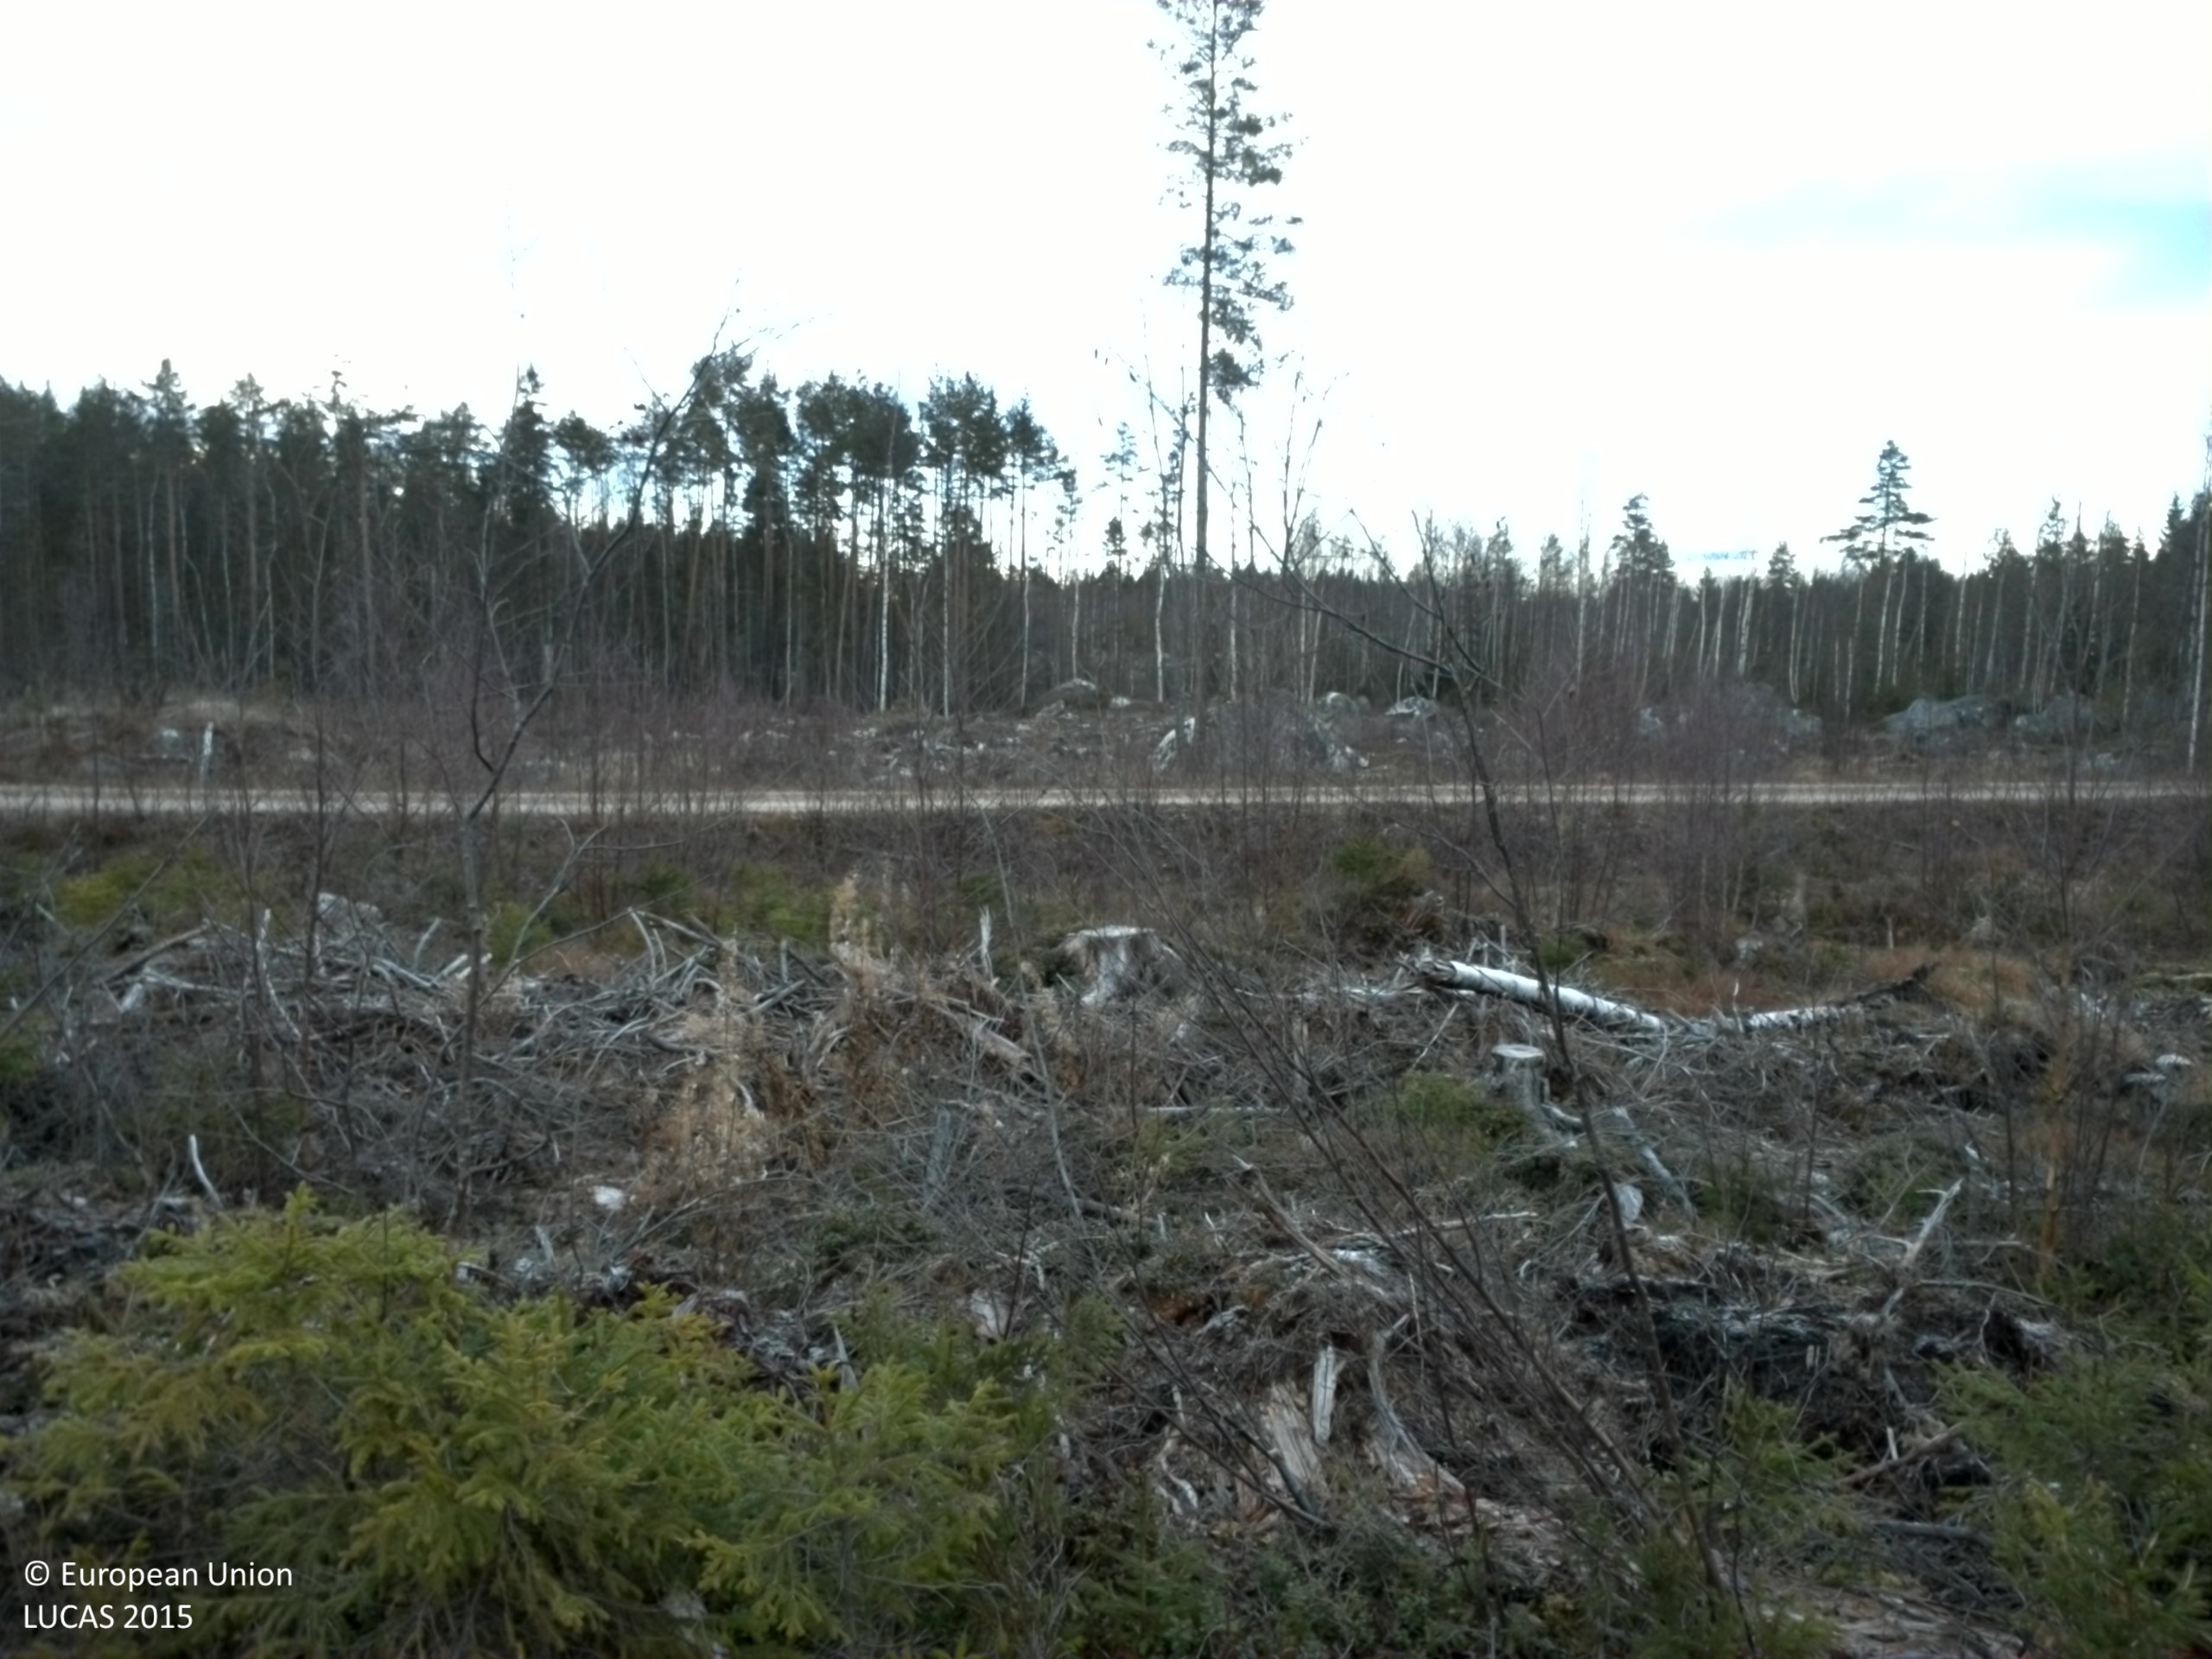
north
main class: Woodland
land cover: Spruce dominated mixed woodland
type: boreal forest
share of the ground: 10 - 25 %
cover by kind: shrubs 30 %, unconsolidated bare surface 20 %, lichens and mosses 15 %, broadleaved forest trees 10 %, herbaceous plants 10 %, consolidated bare surface 10 %, coniferous forest trees 5 %
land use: Forestry
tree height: < 5 m
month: December
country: SE
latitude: 61.3276
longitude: 16.9919
